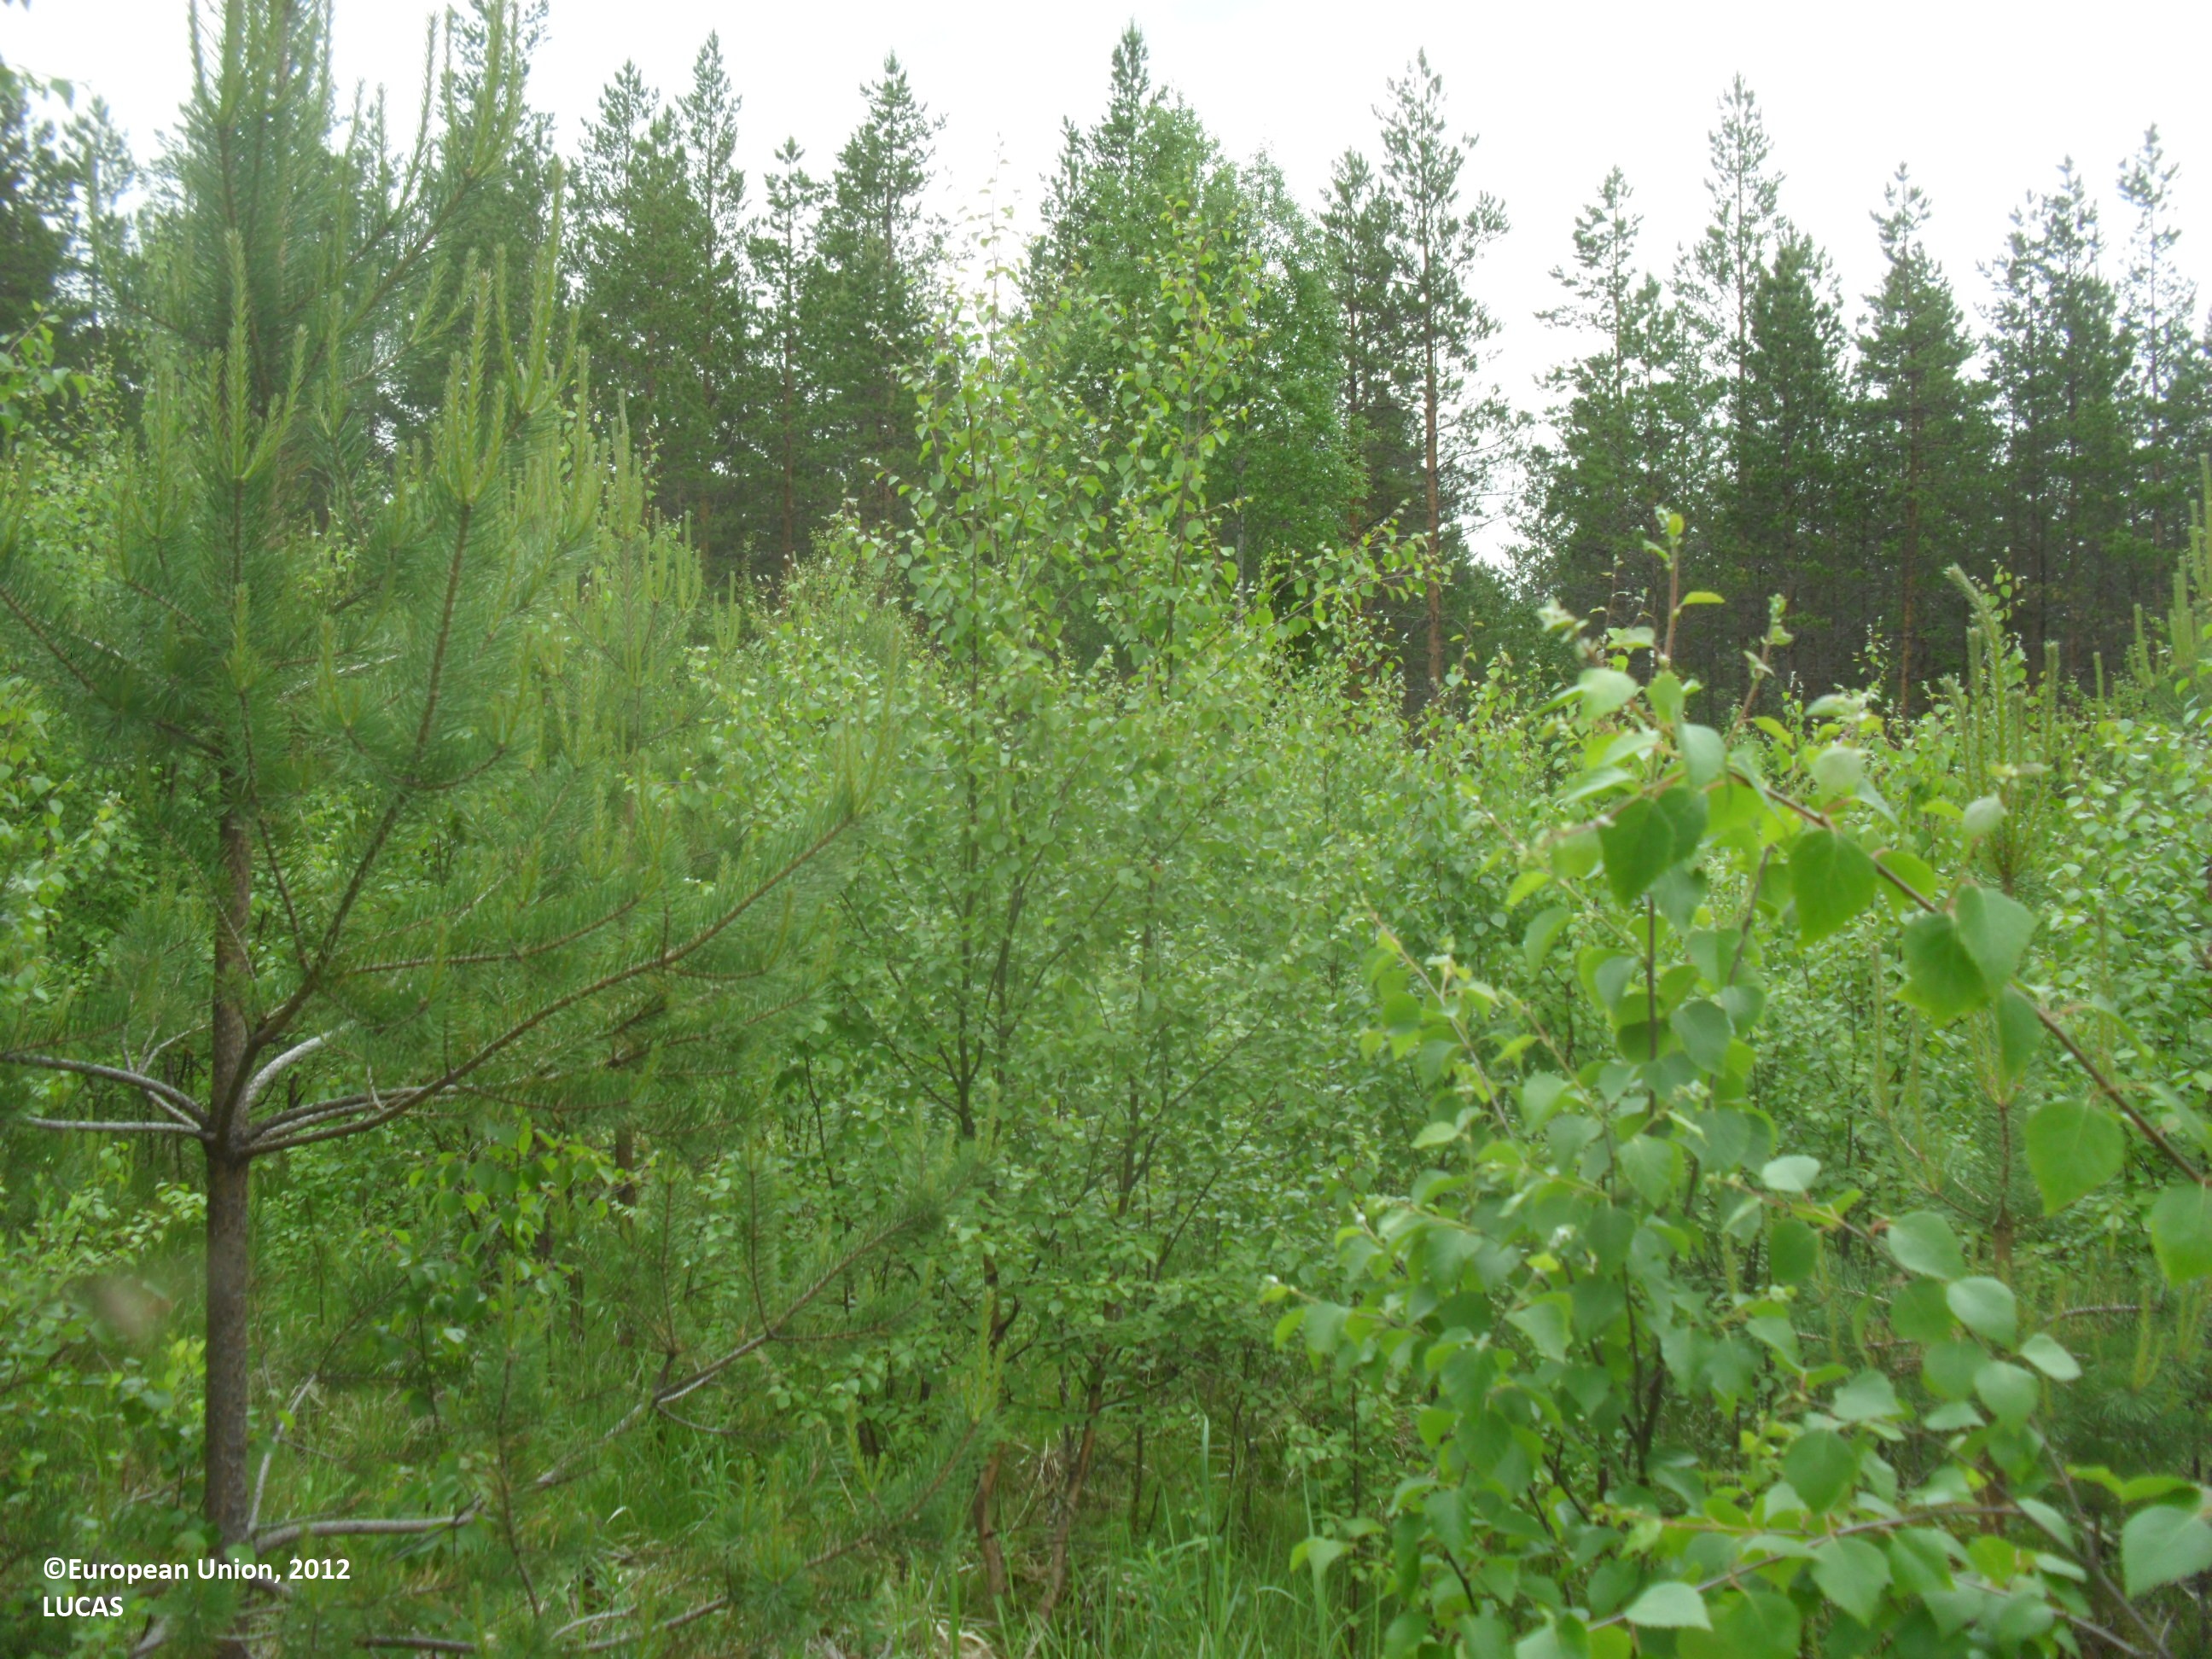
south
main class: Woodland
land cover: Pine dominated mixed woodland
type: boreal forest
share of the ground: 25 - 50 %
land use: Forestry
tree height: < 5 m
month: June
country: FI
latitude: 63.3999
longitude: 23.6576
